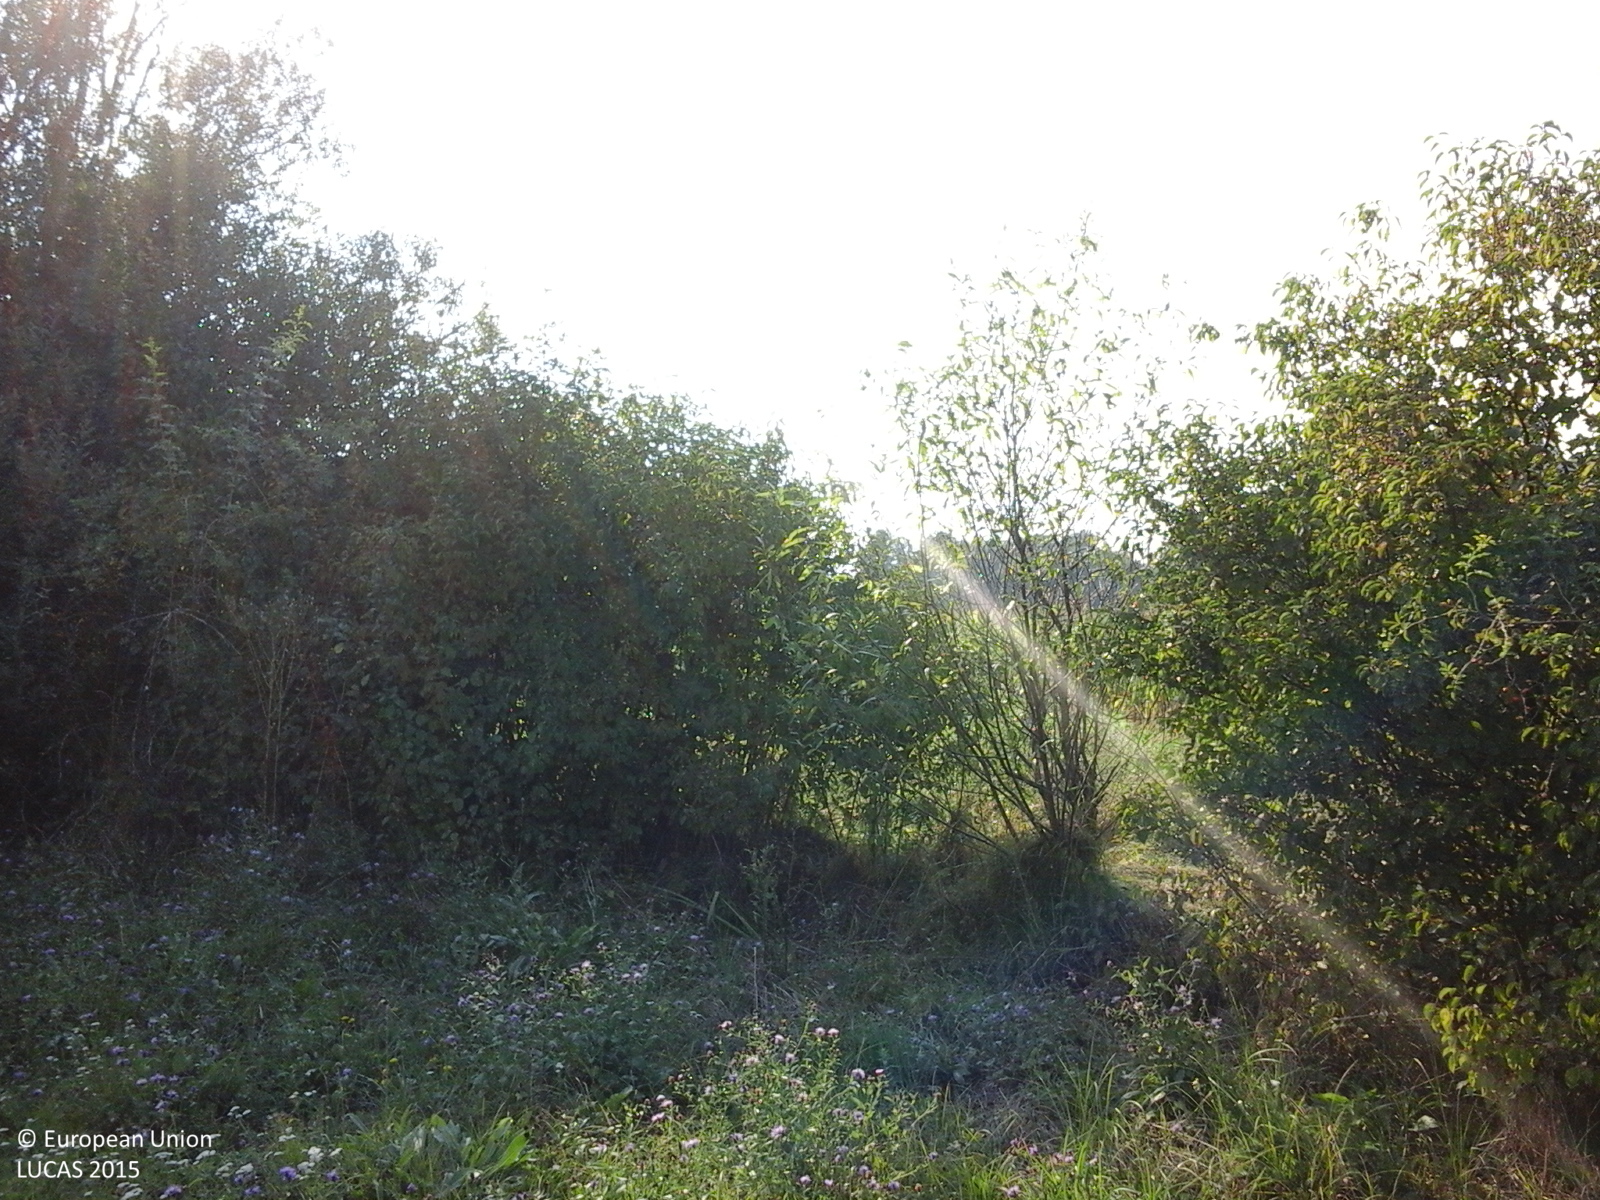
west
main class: Cropland
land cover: Other leguminous and mixtures for fodder
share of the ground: > 75 %
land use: Agriculture (excluding fallow land and kitchen gardens)
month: August
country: RO
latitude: 46.0851
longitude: 22.0568
